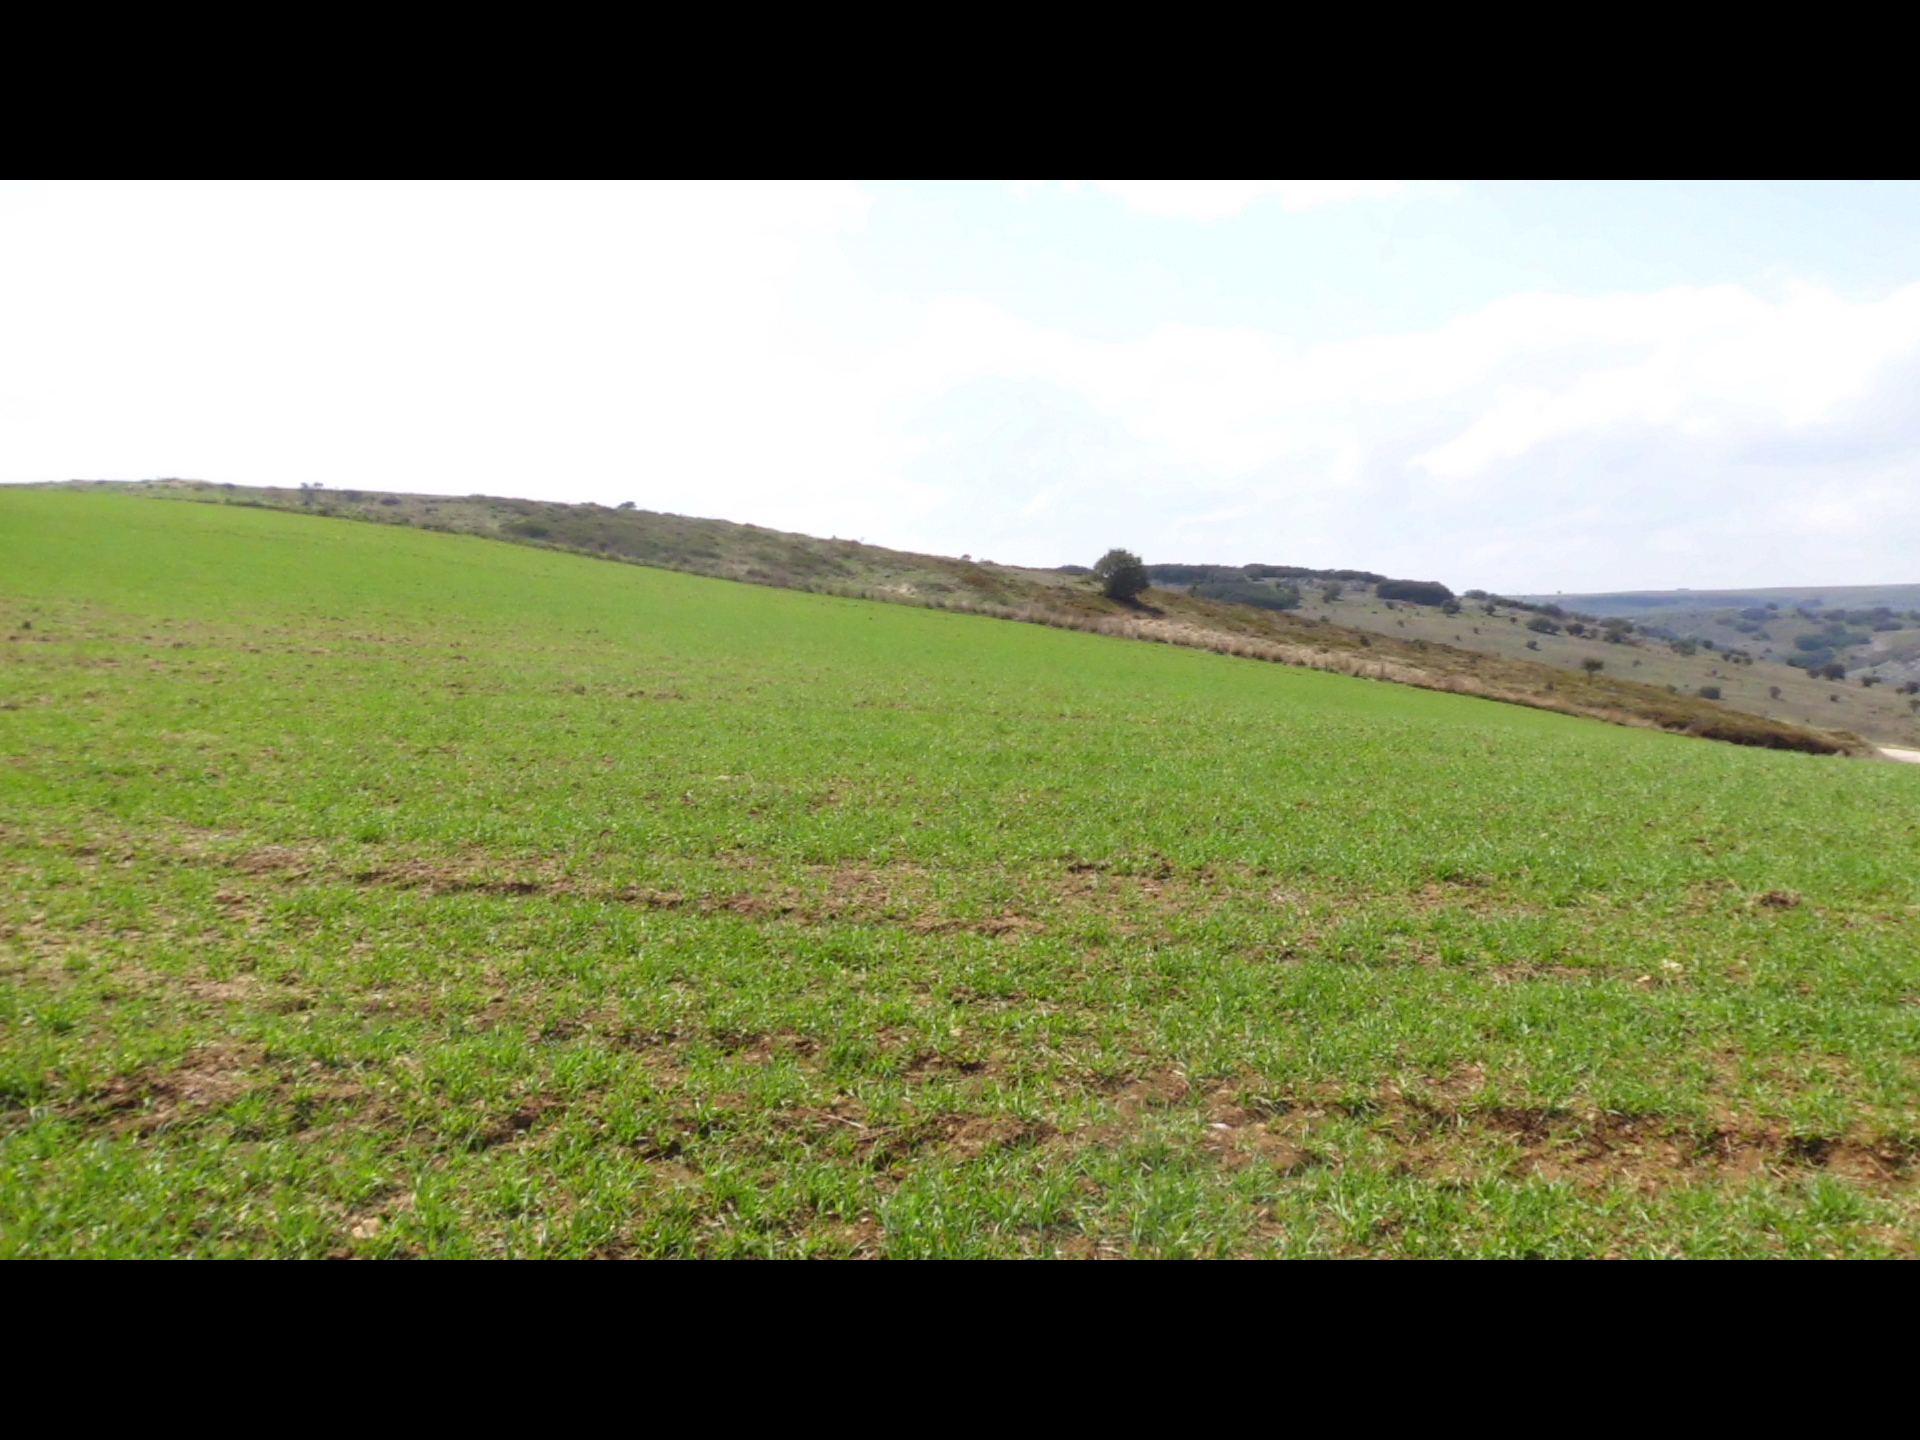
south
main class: Cropland
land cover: Barley
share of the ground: > 75 %
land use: Agriculture (excluding fallow land and kitchen gardens)
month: April
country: ES
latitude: 42.5218
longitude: -3.7083
